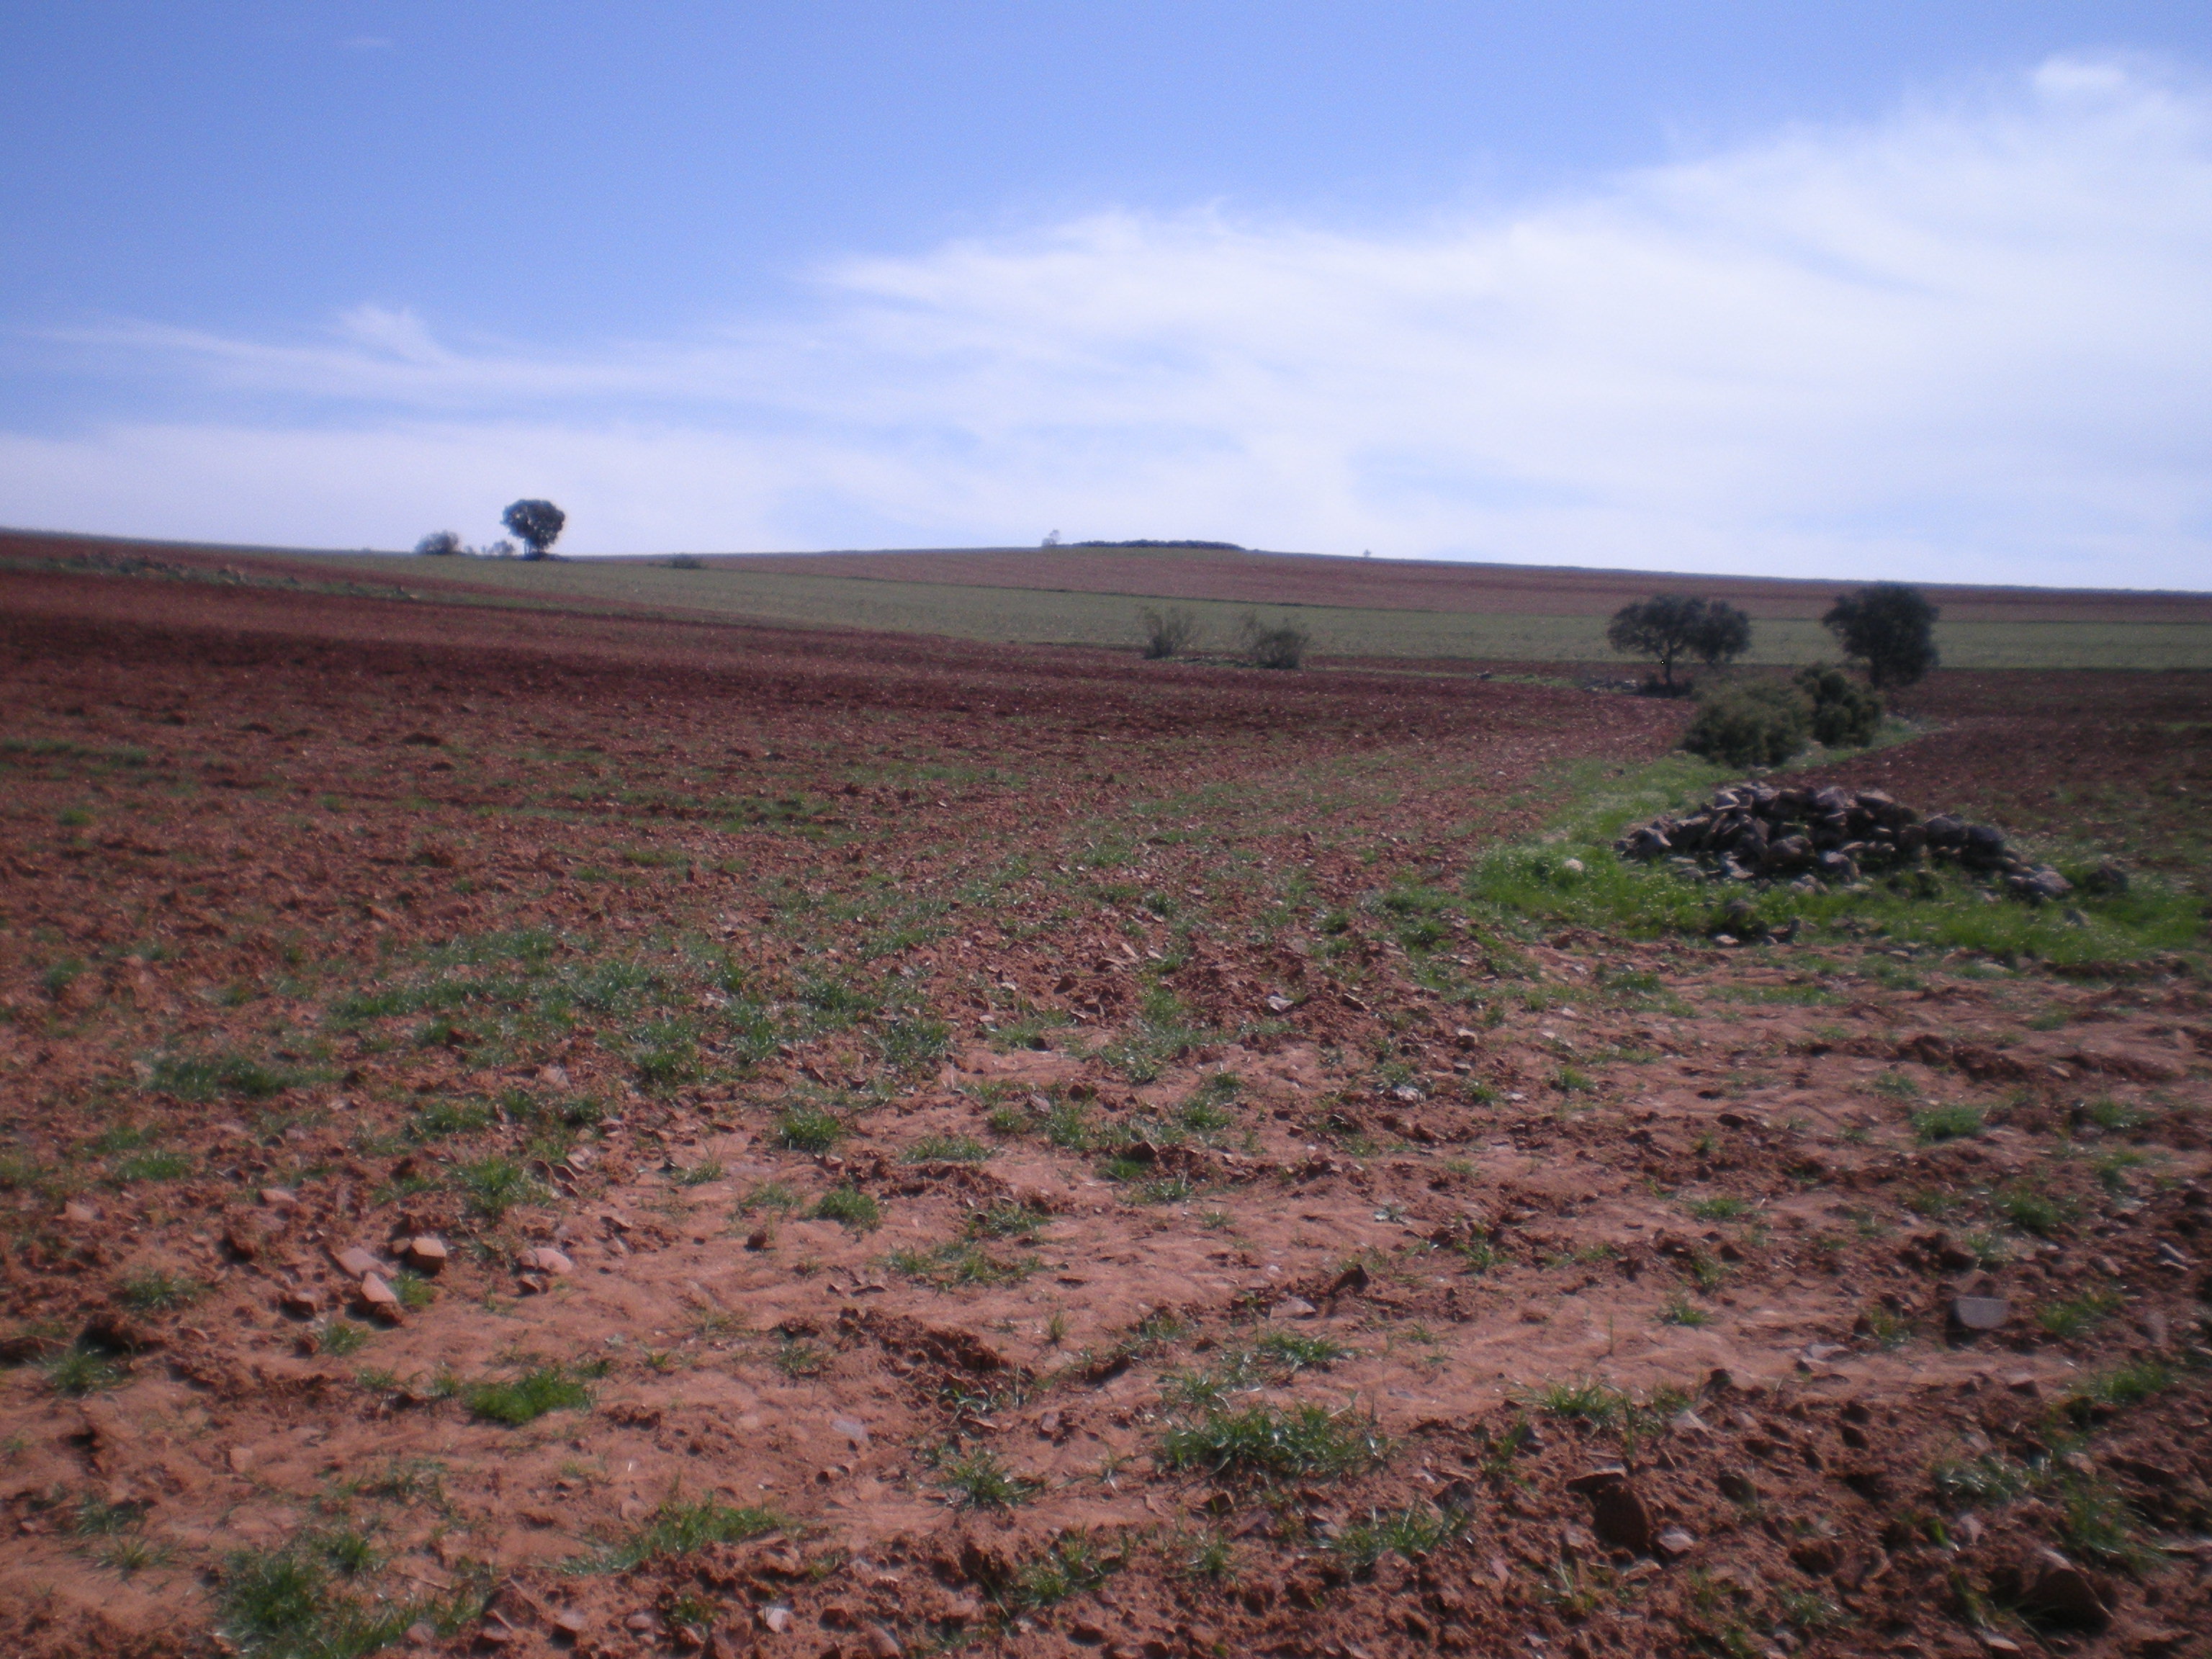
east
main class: Grassland
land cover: Spontaneously vegetated surfaces
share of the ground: 10 - 25 %
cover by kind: unconsolidated bare surface 80 %, herbaceous plants 20 %
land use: Fallow land
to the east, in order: Spontaneously vegetated surfaces; Grass margins; Spontaneously vegetated surfaces; Other bare soil; Grass margins; Single bushes/trees; Grass margins; Other bare soil; Broadleaved woodland; Spontaneously vegetated surfaces
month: April
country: ES
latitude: 38.5219
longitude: -3.5089
